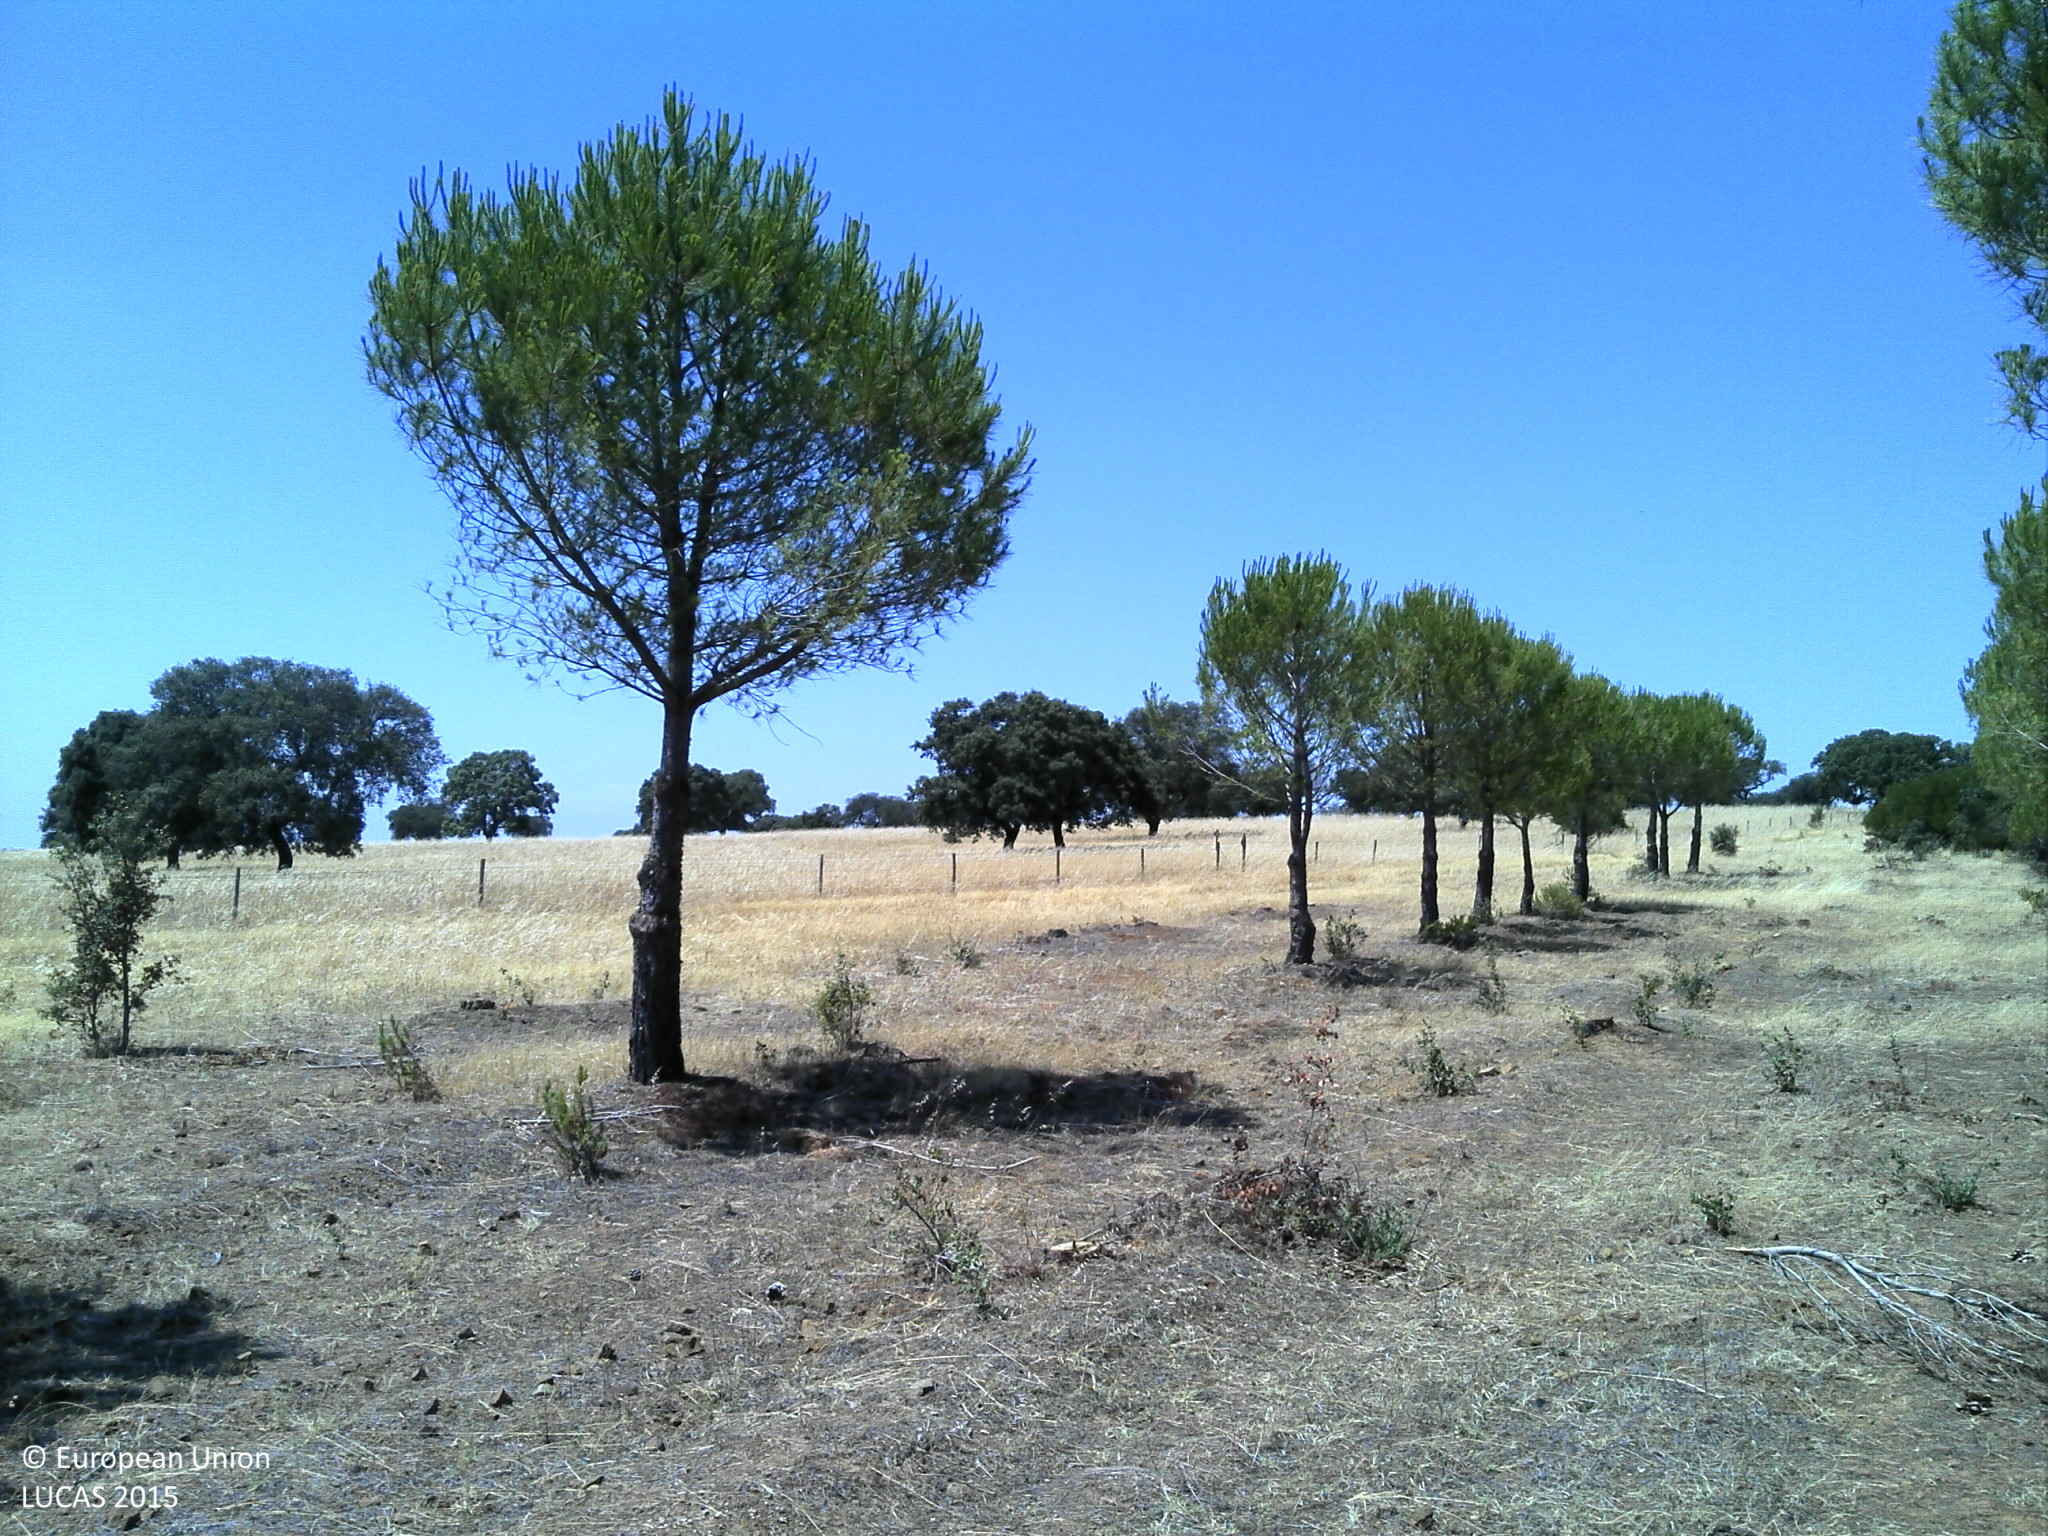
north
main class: Woodland
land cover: Pine dominated coniferous woodland
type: coniferous forest of the mediterranean region
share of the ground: 25 - 50 %
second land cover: Grassland without tree/shrub cover
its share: 10 - 25 %
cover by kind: unconsolidated bare surface 50 %, coniferous forest trees 40 %, herbaceous plants 10 %
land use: Forestry
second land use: Agriculture (excluding fallow land and kitchen gardens)
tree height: > 5 m
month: June
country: PT
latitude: 38.1381
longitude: -8.0266
